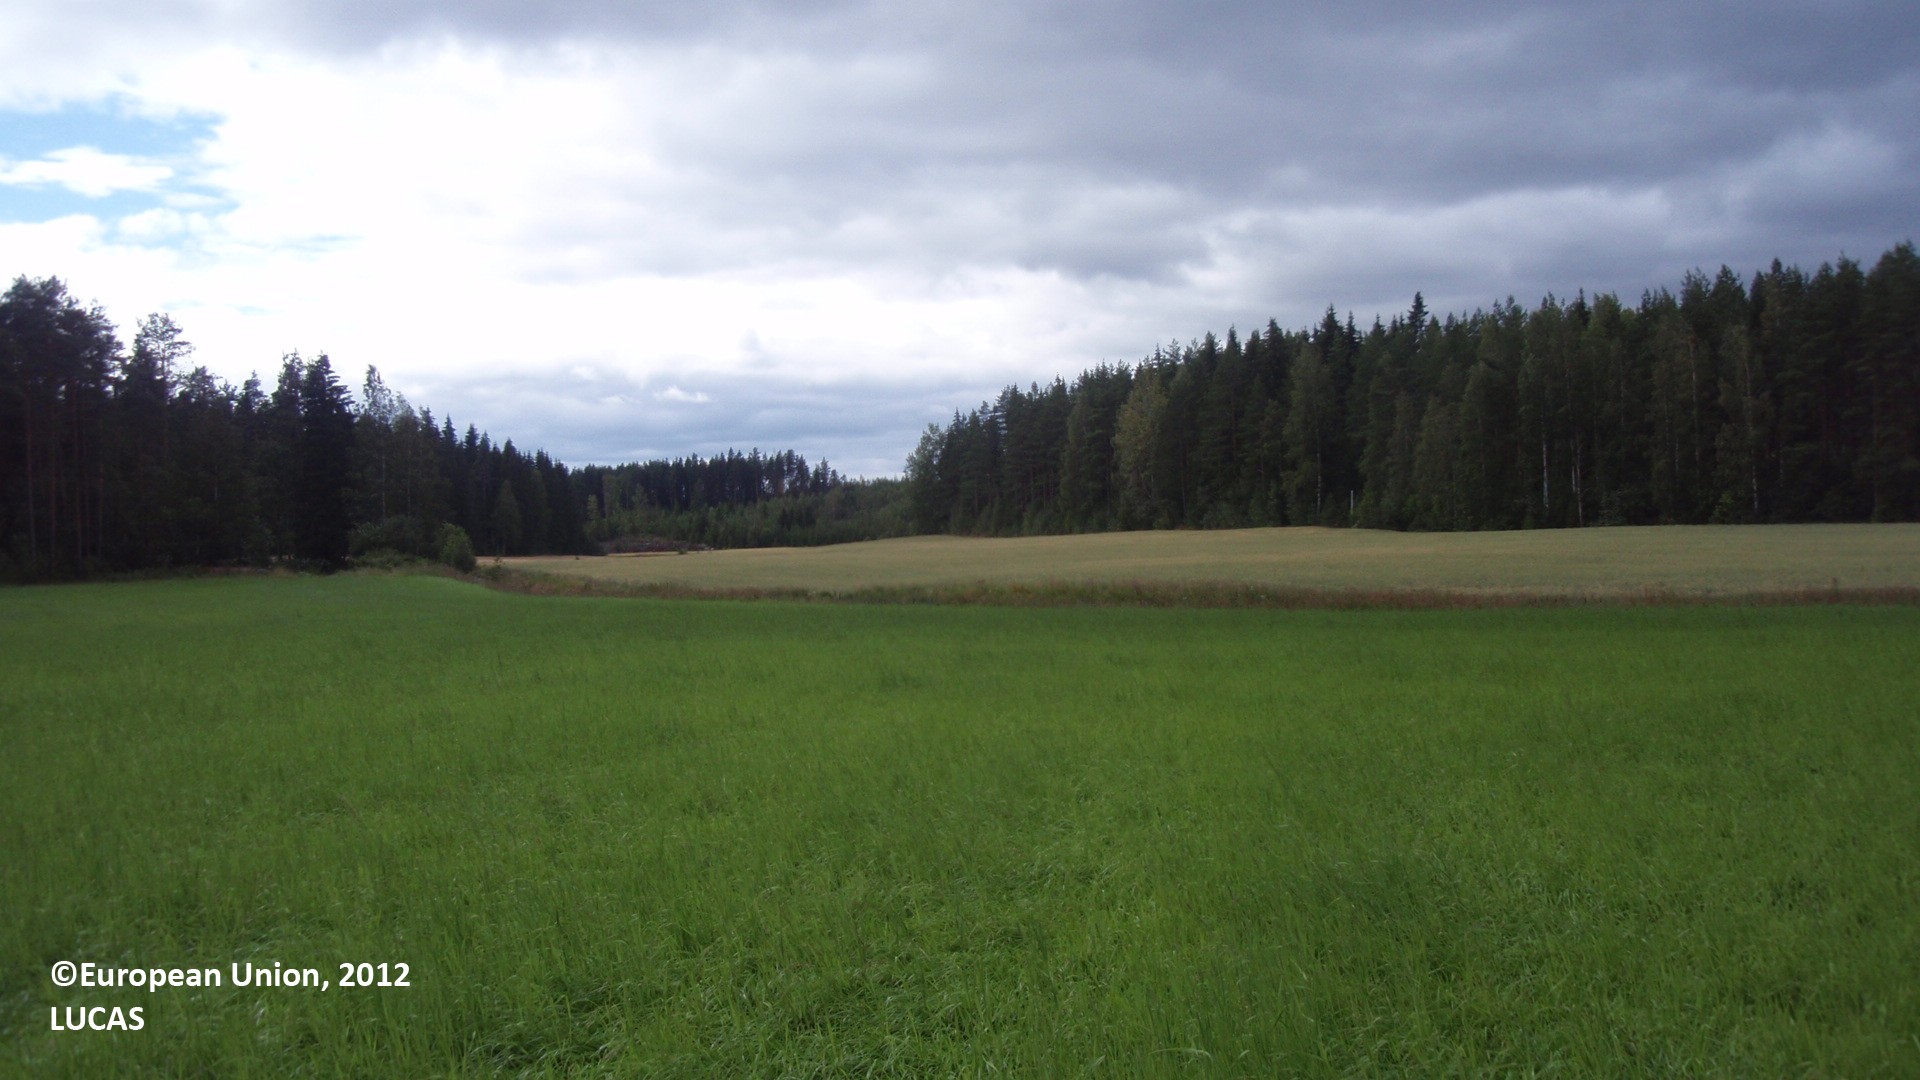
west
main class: Cropland
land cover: Mixed cereals for fodder
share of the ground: > 75 %
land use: Agriculture (excluding fallow land and kitchen gardens)
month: August
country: FI
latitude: 61.1108
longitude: 27.6467
